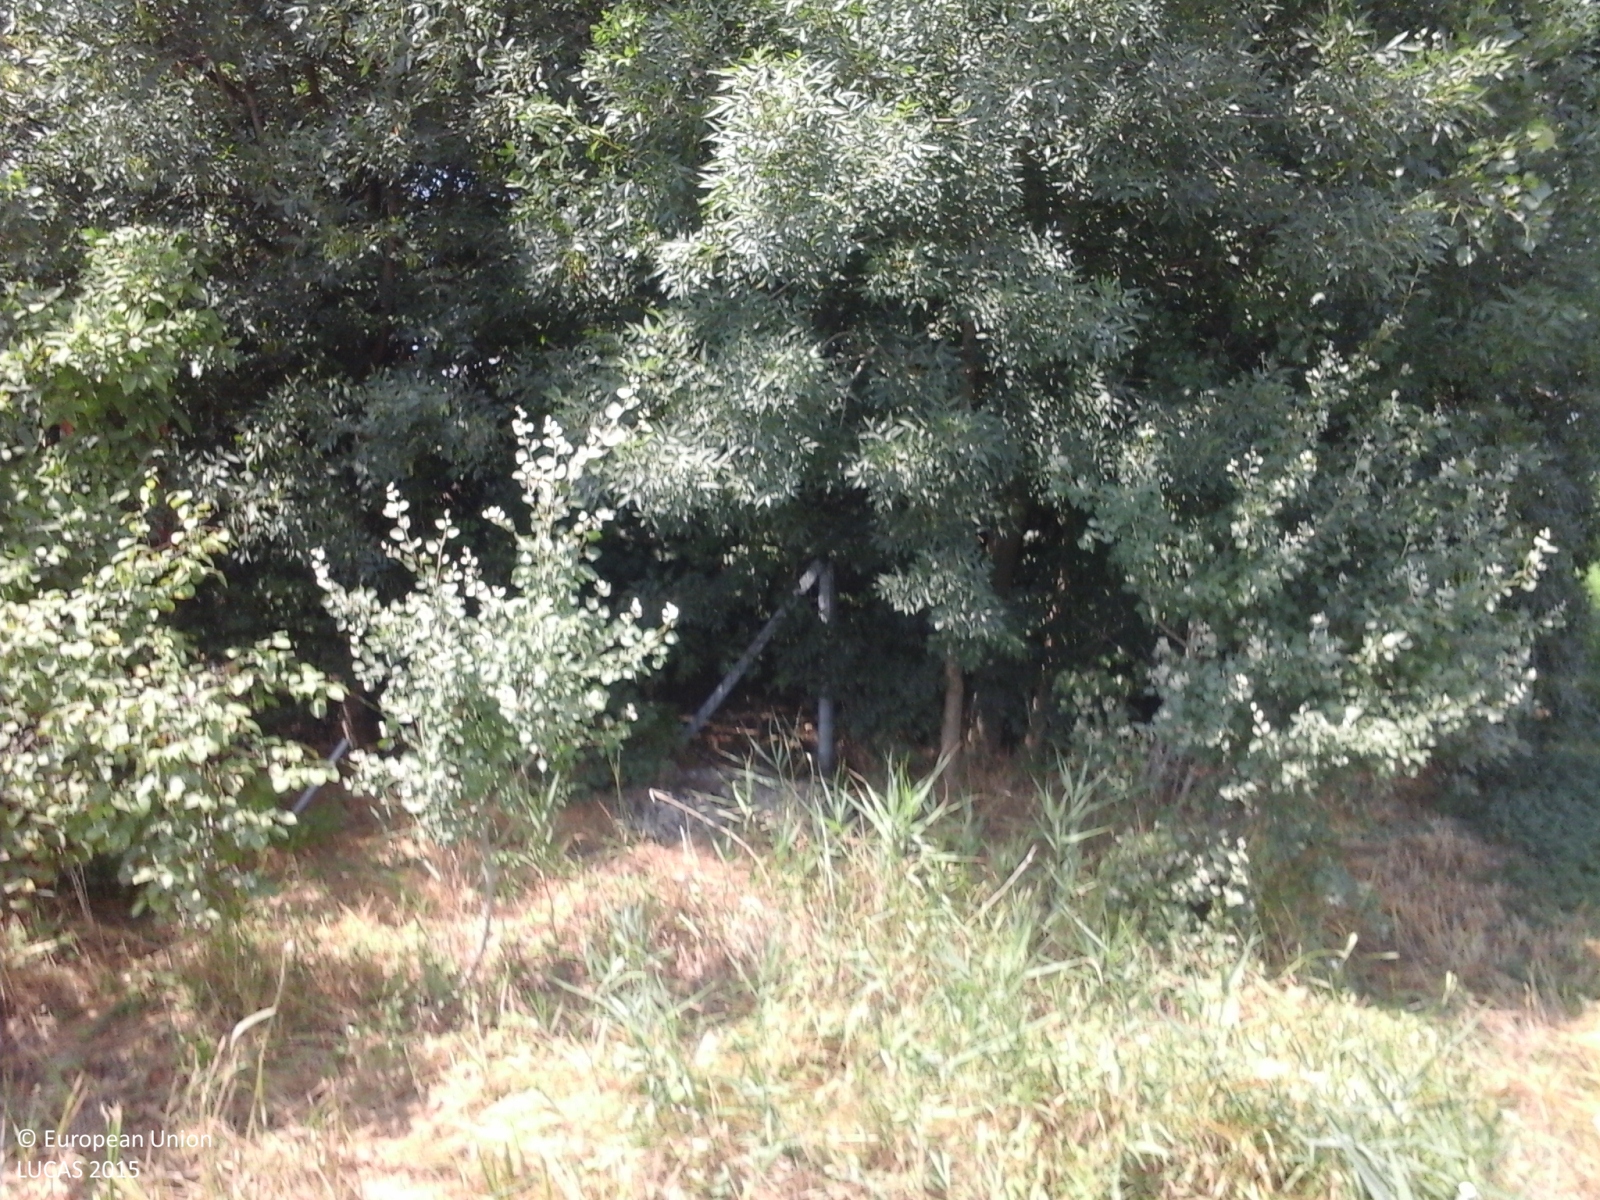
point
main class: Woodland
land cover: Broadleaved woodland
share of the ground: > 75 %
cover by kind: broadleaved forest trees 100 %
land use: Residential
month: June
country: IT
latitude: 44.8137
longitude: 11.0979
